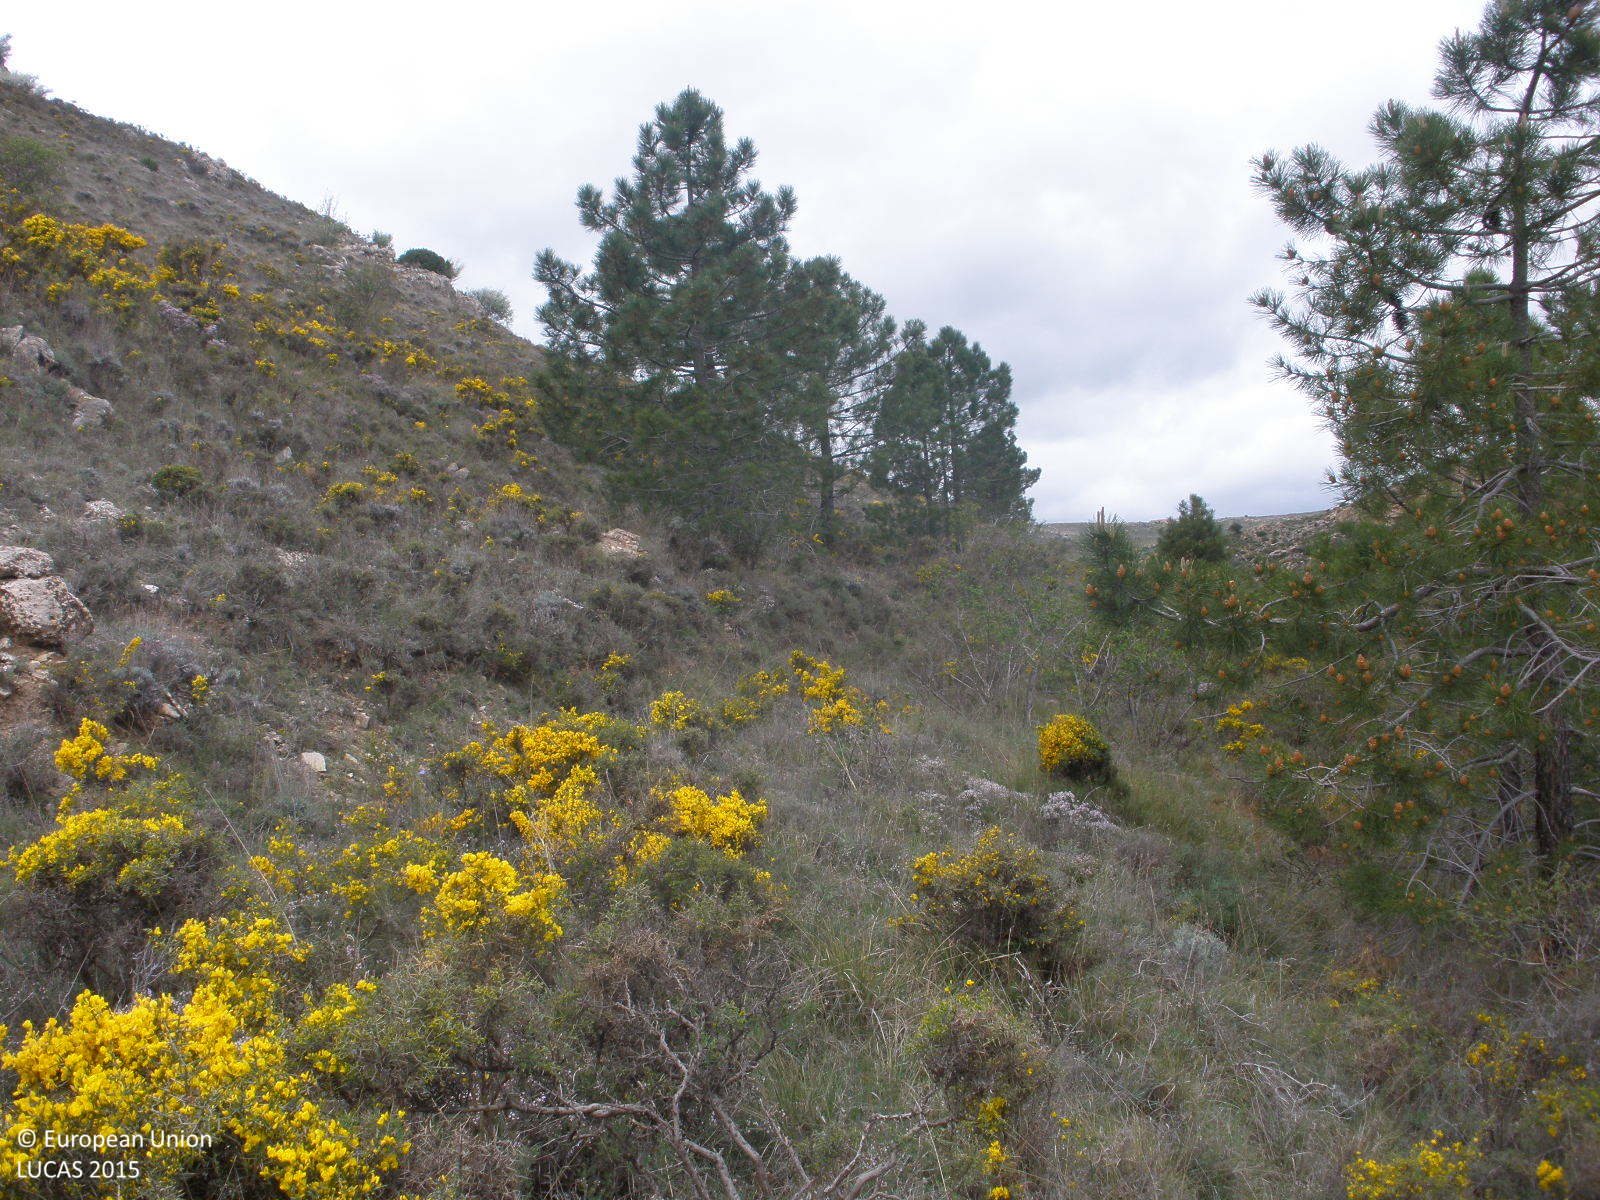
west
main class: Woodland
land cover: Pine dominated coniferous woodland
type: coniferous forest of the mediterranean region
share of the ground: 10 - 25 %
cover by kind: shrubs 50 %, herbaceous plants 30 %, coniferous forest trees 20 %
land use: Semi-natural and natural areas not in use
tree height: < 5 m
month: May
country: ES
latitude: 40.9671
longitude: -0.9358
